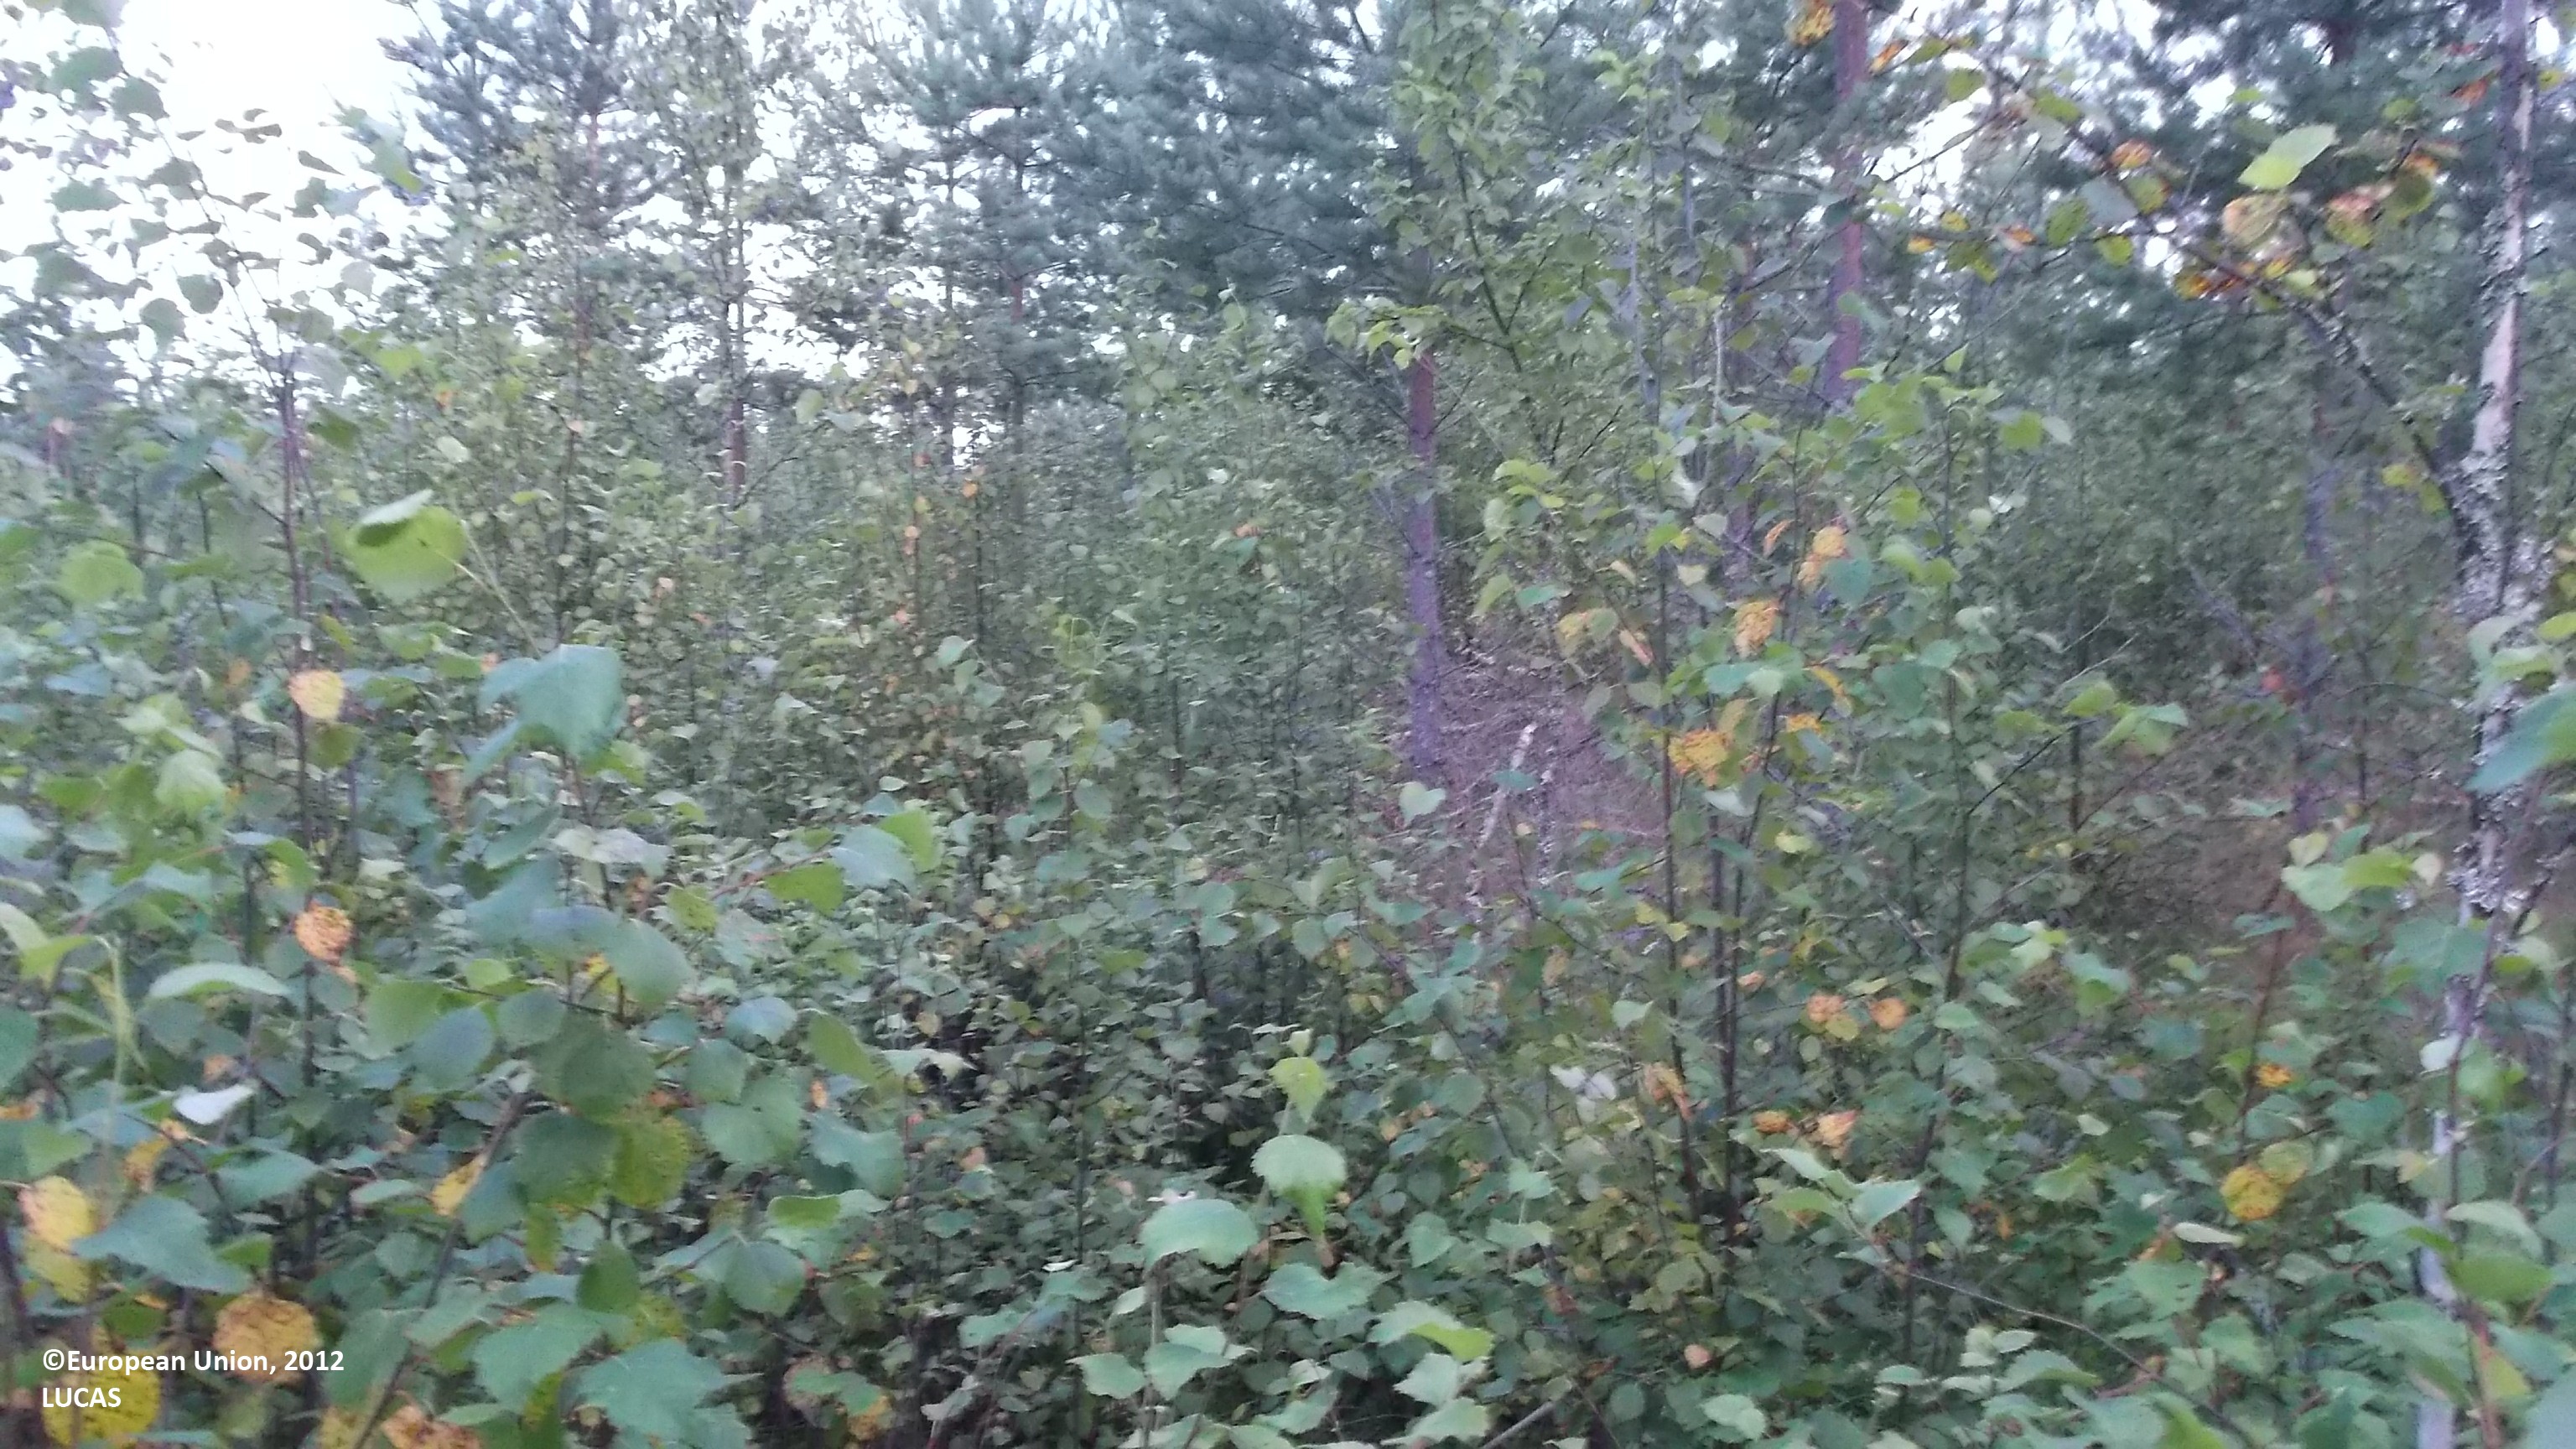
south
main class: Woodland
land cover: Broadleaved woodland
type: boreal forest
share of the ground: 25 - 50 %
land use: Forestry
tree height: < 5 m
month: August
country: FI
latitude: 63.0757
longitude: 23.7887
